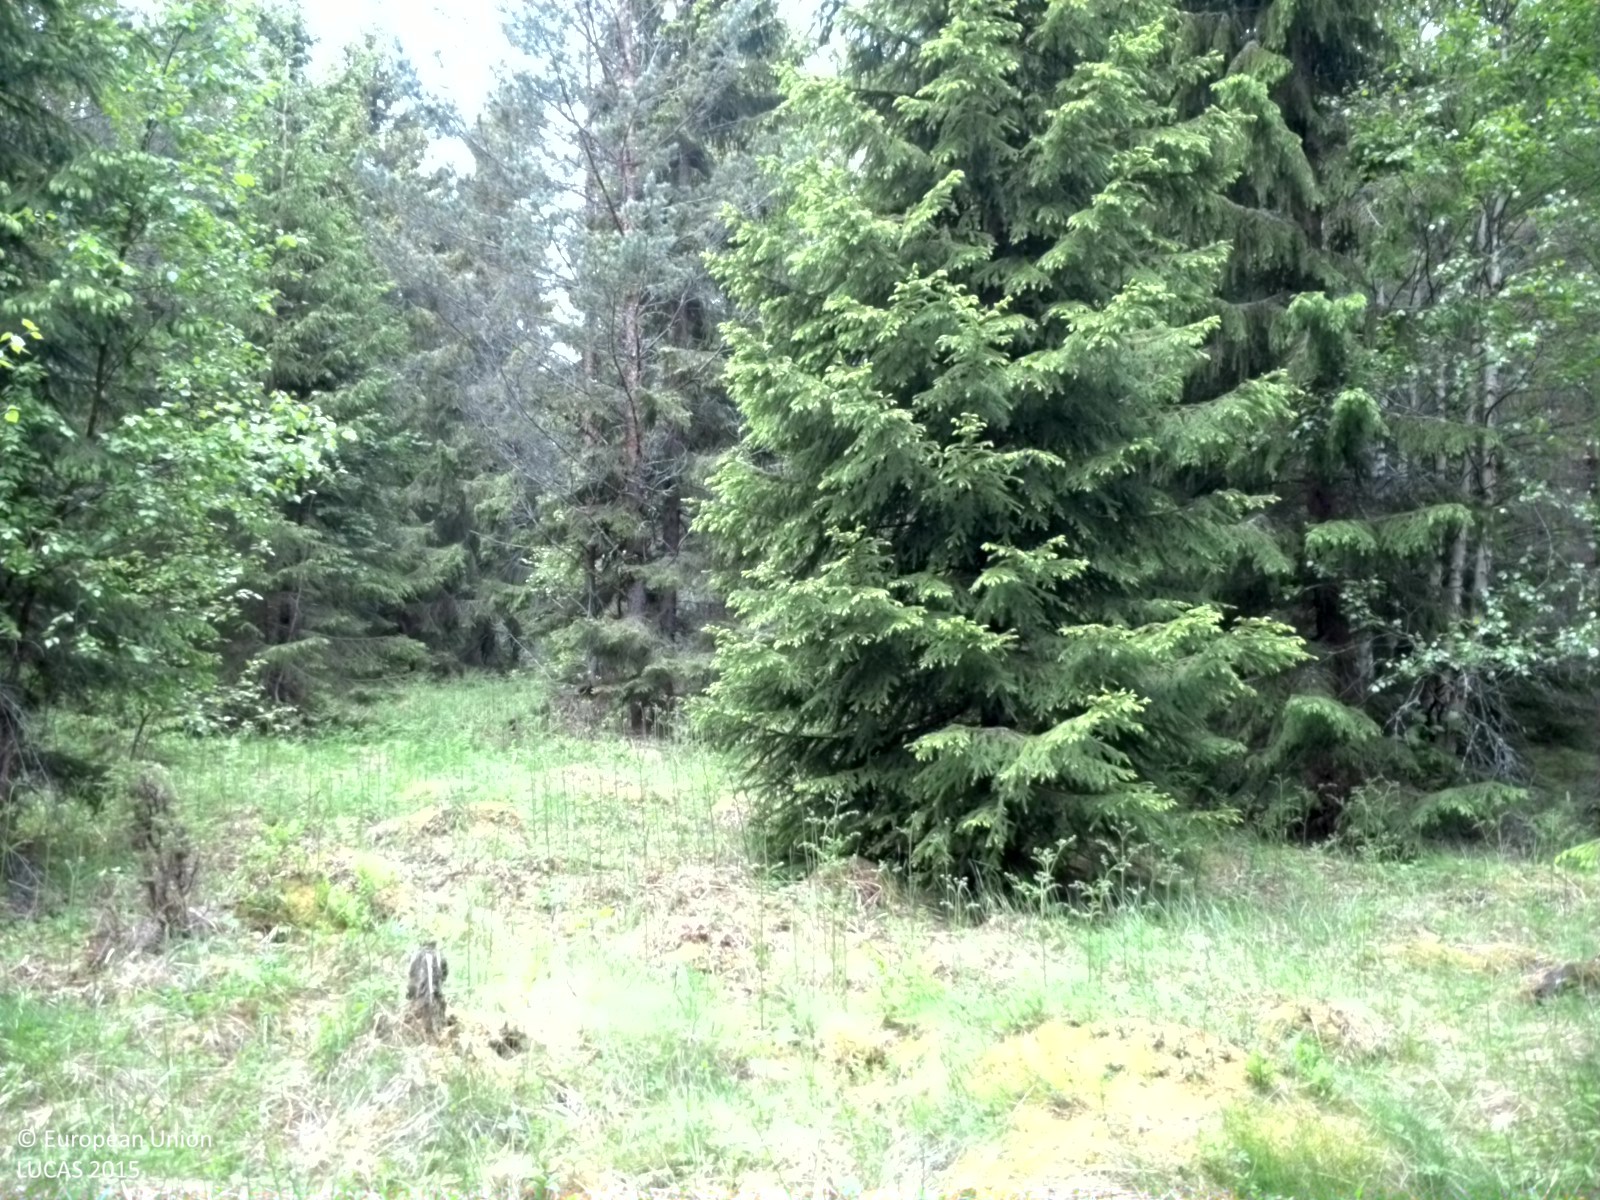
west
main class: Woodland
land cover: Spruce dominated coniferous woodland
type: boreal forest
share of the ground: 50 - 75 %
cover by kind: coniferous forest trees 45 %, herbaceous plants 20 %, broadleaved forest trees 15 %, shrubs 5 %, lichens and mosses 5 %
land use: Forestry
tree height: > 5 m
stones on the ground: 10 - 25 %
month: June
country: SE
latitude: 60.2912
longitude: 17.0998
